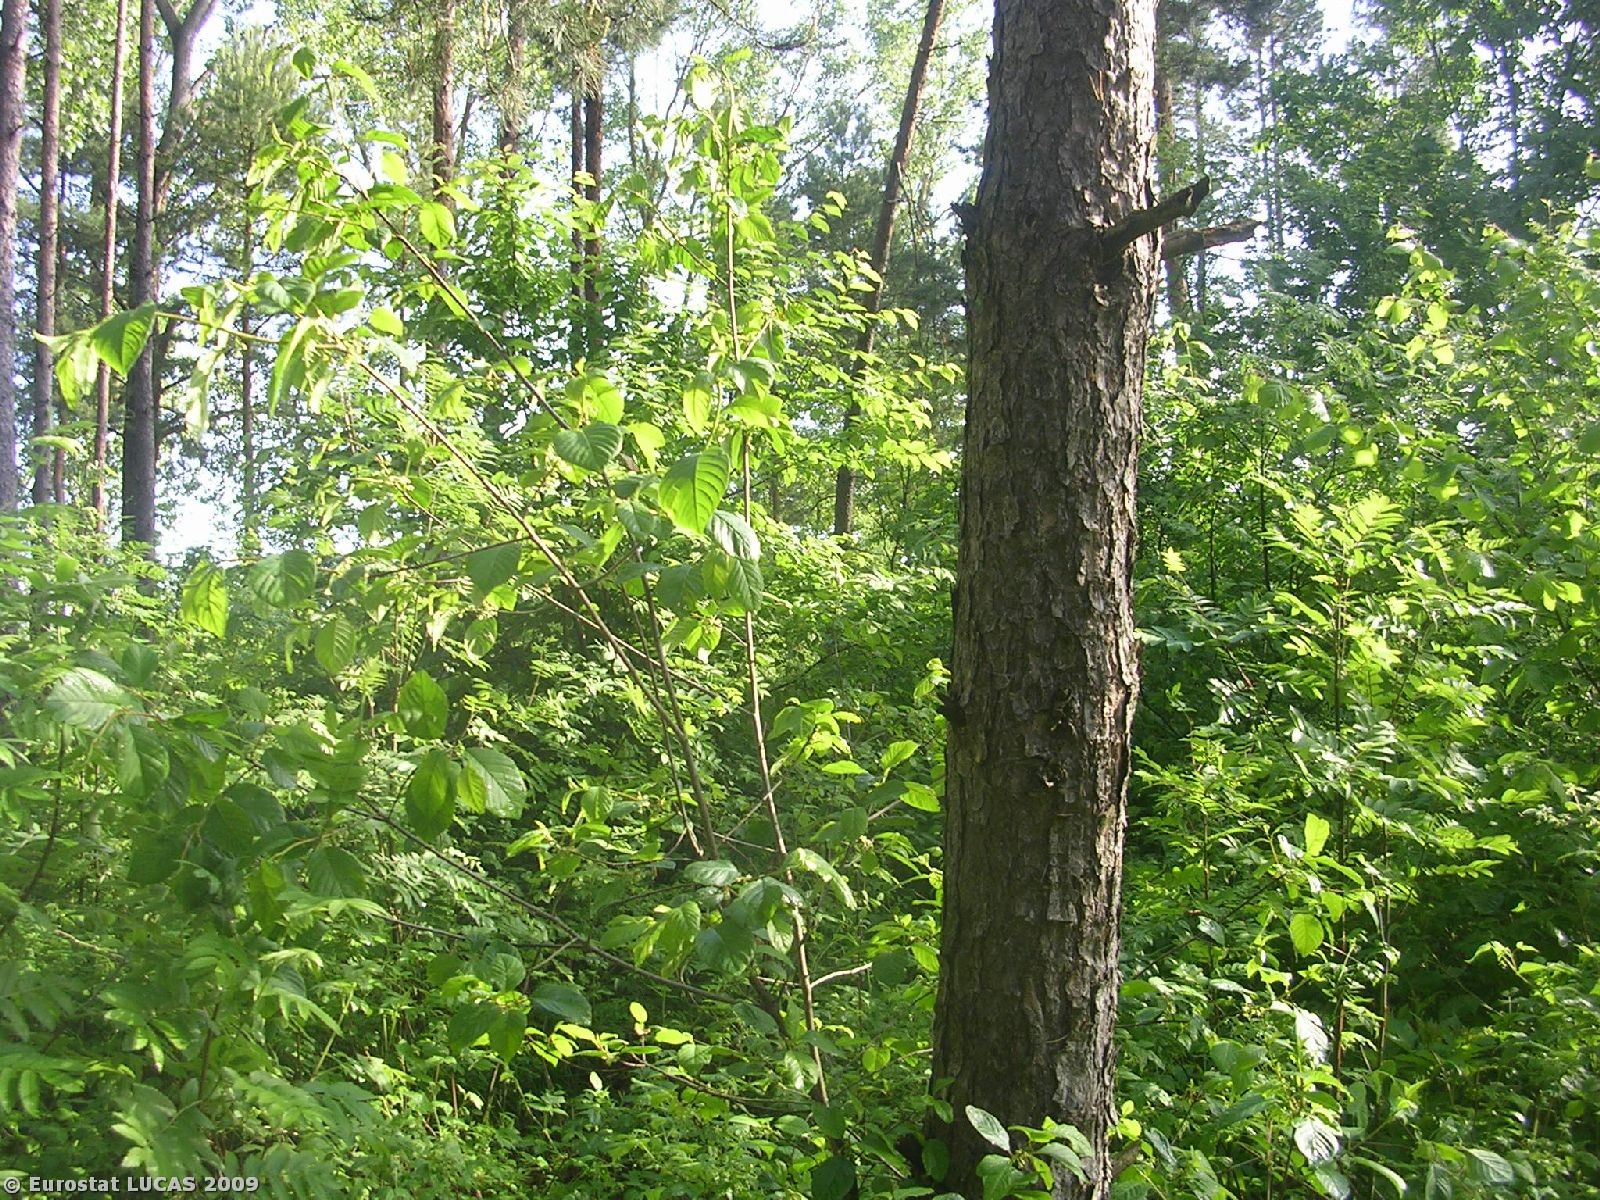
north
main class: Woodland
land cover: Mixed woodland
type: hemiboreal forest and nemoral coniferous forest and mixed broadleaved-coniferous forest
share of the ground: 25 - 50 %
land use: Forestry
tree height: > 5 m
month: May
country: PL
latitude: 53.2350
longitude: 23.2483
